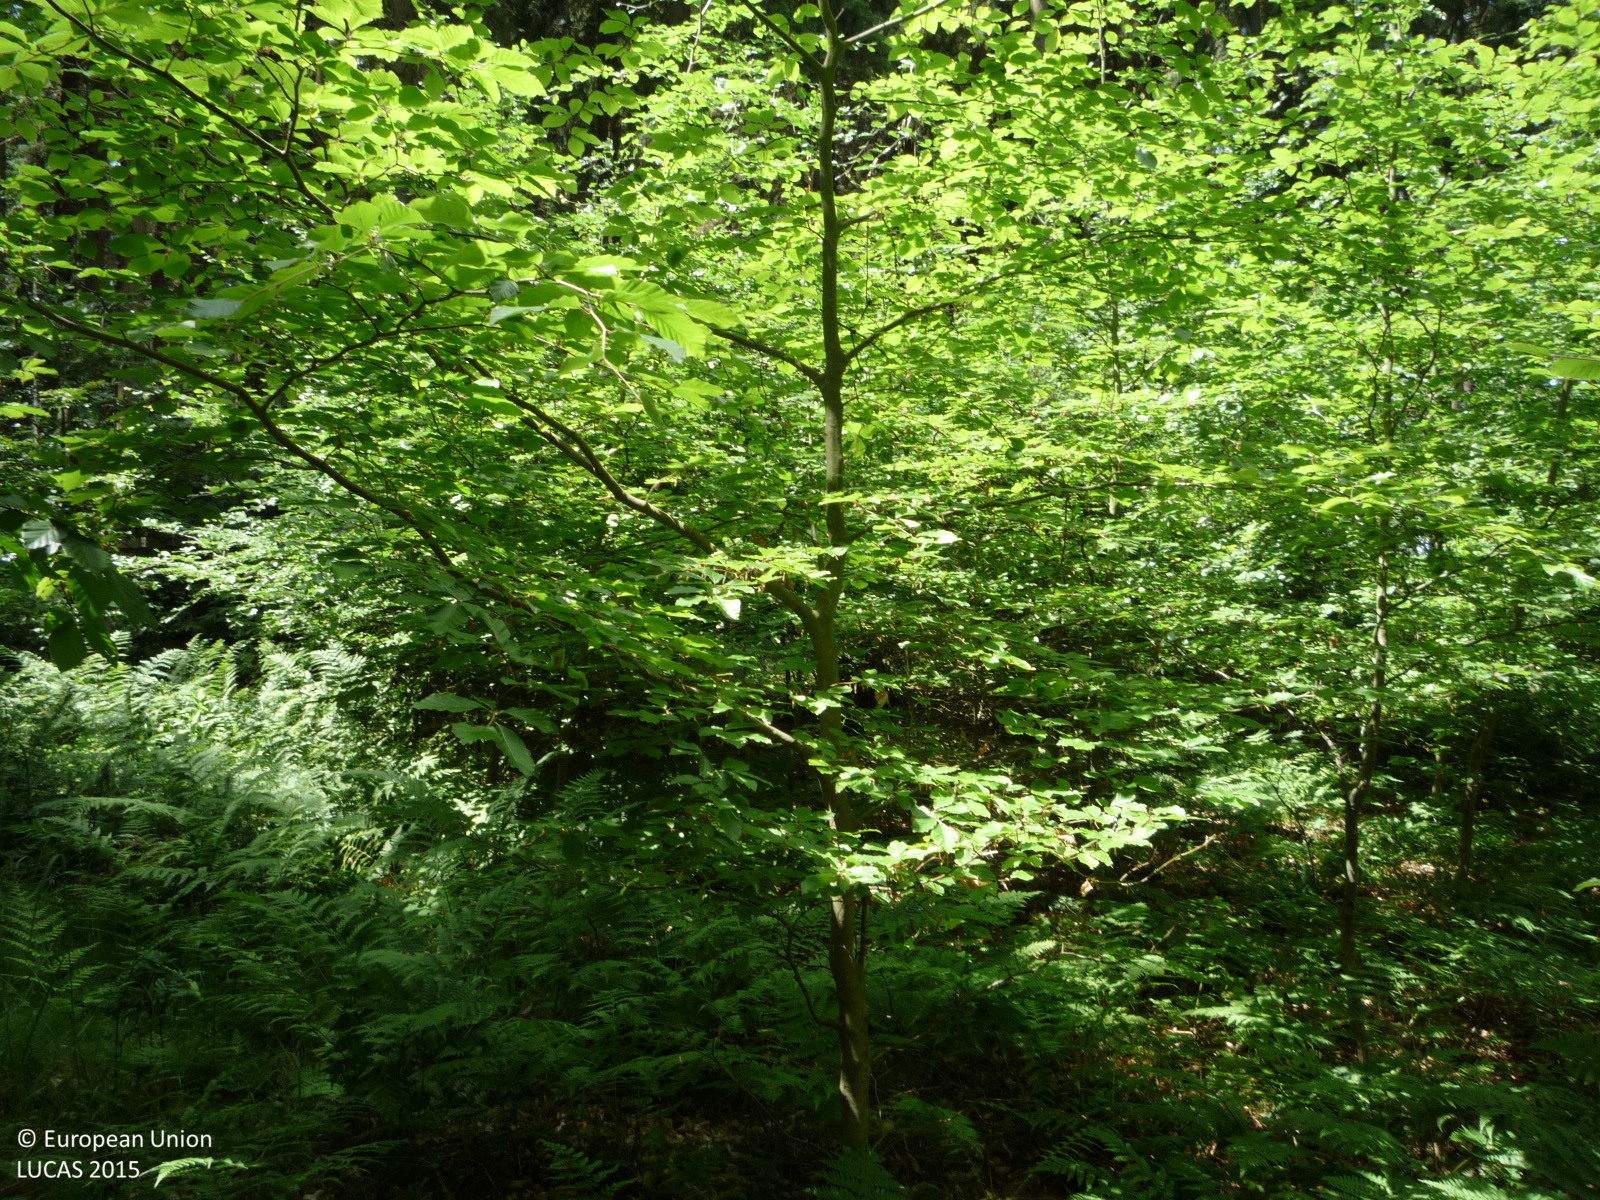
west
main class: Woodland
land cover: Spruce dominated mixed woodland
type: hemiboreal forest and nemoral coniferous forest and mixed broadleaved-coniferous forest
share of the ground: > 75 %
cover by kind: broadleaved forest trees 45 %, coniferous forest trees 40 %, lichens and mosses 10 %, unconsolidated bare surface 5 %
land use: Forestry
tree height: > 5 m
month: June
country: CZ
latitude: 49.7064
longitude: 15.1752
